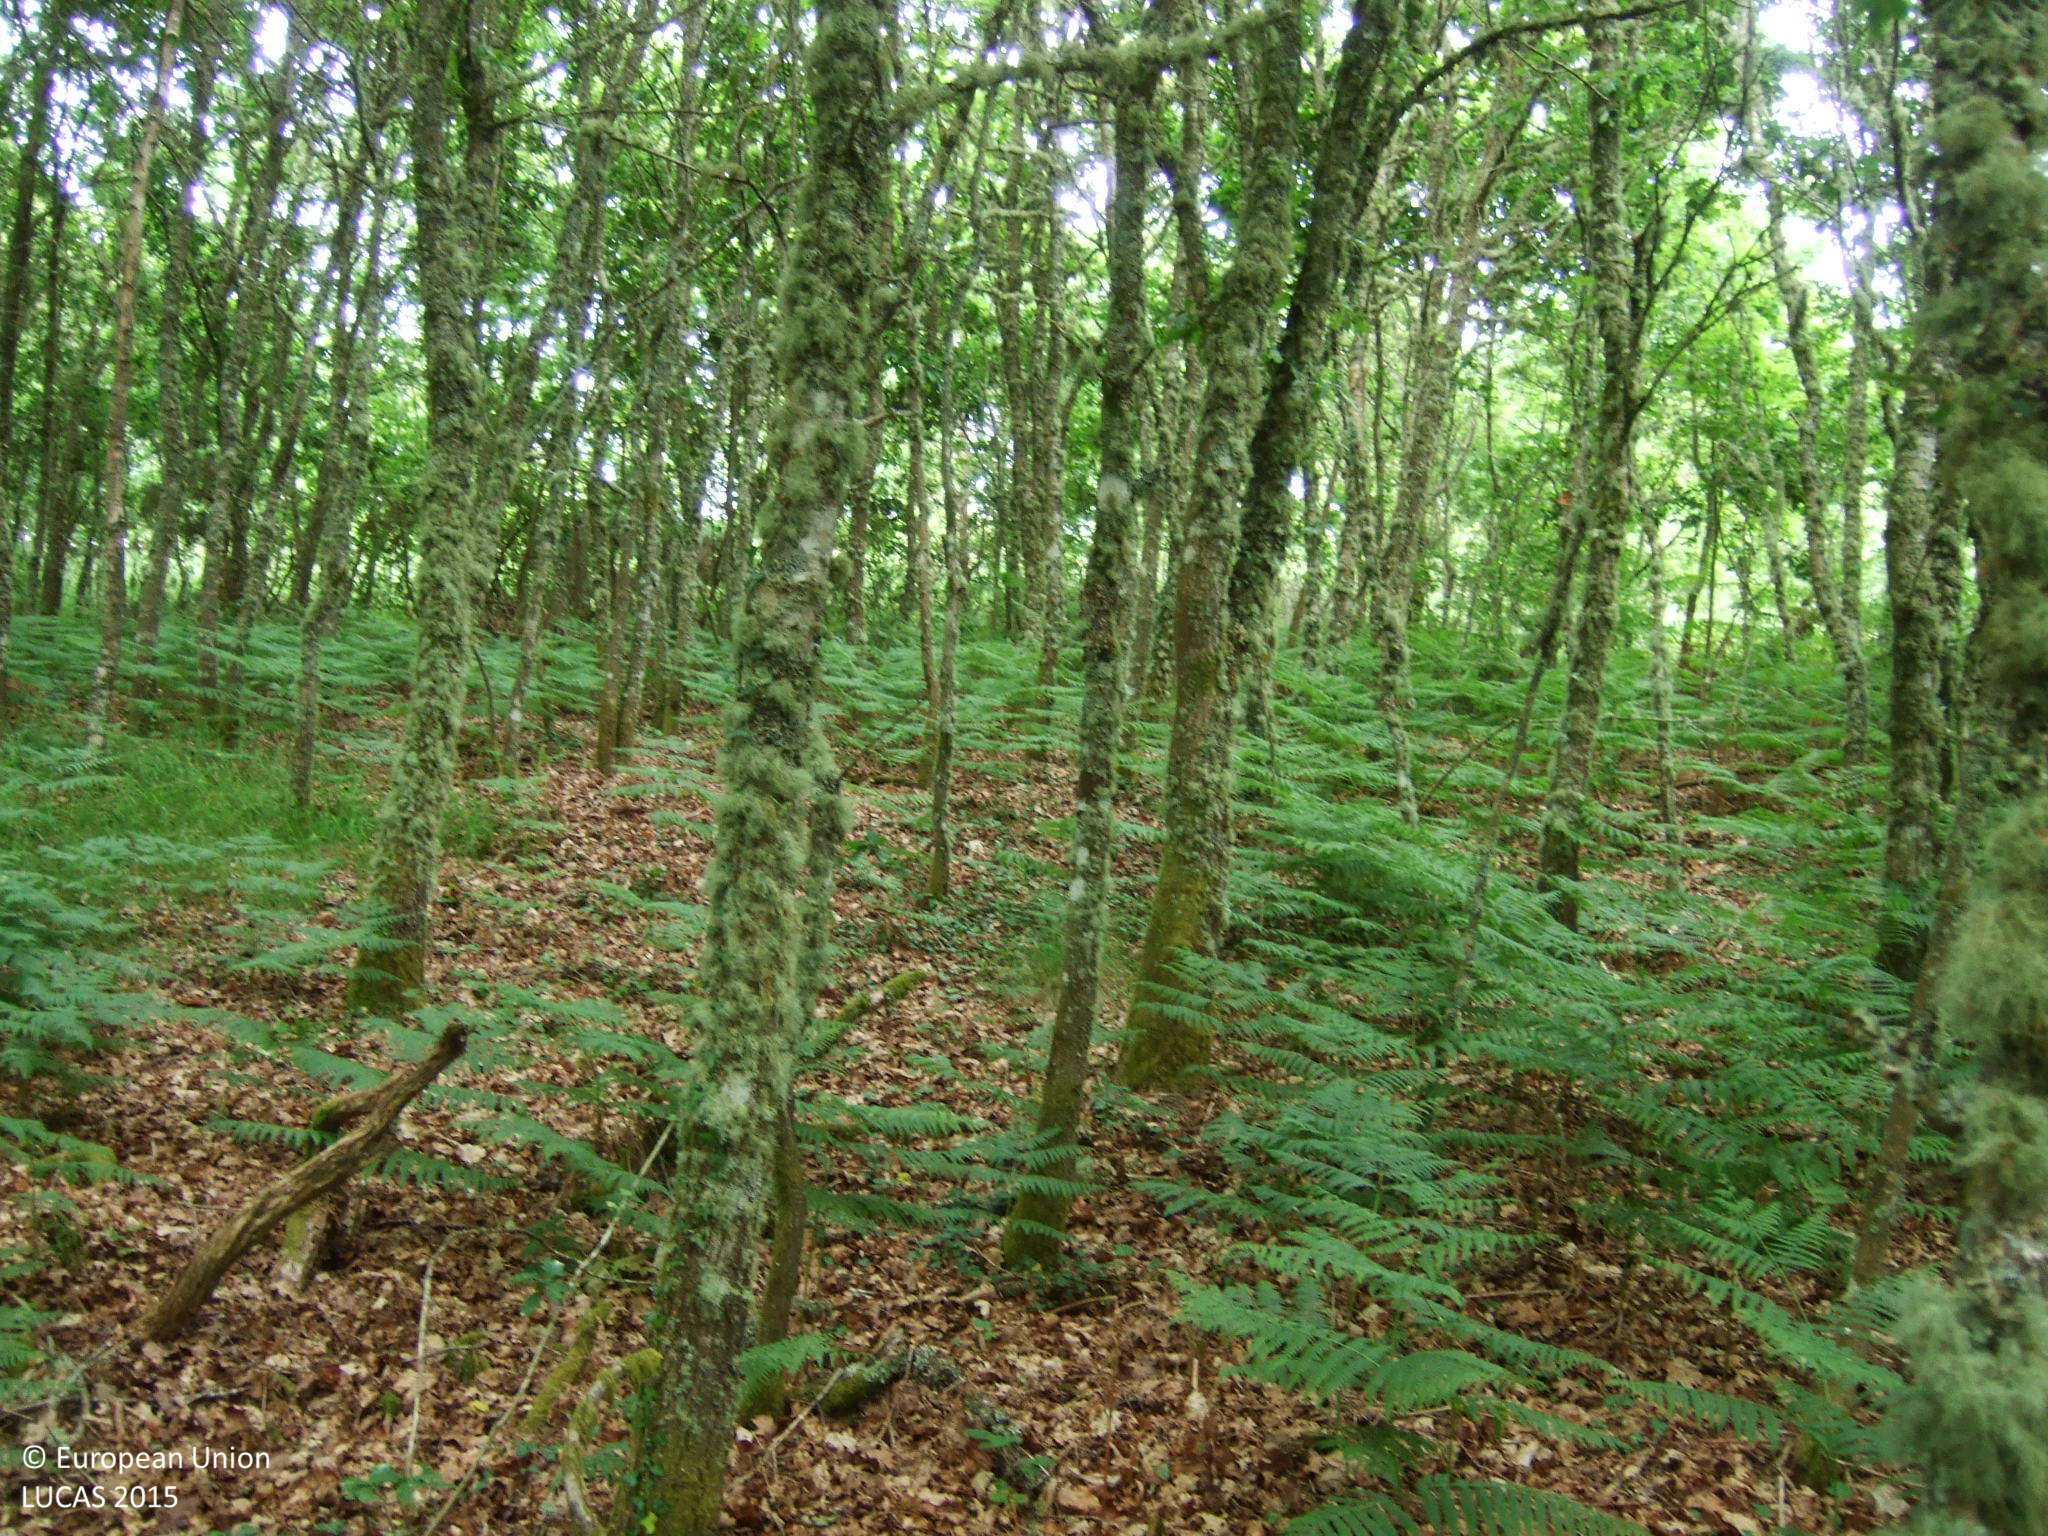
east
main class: Woodland
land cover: Broadleaved woodland
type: acidophilous oak and oak-birch forest
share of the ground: 50 - 75 %
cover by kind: broadleaved forest trees 70 %, shrubs 15 %, herbaceous plants 15 %
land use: Forestry
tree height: > 5 m
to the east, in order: Broadleaved woodland; Fences; Grassland without tree/shrub cover; Broadleaved woodland; Paved roads, cycling and walking lanes; Grassland without tree/shrub cover; Paved roads, cycling and walking lanes; Shruby margins; Temporary grasslands
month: June
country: ES
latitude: 43.3726
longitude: -7.7733
